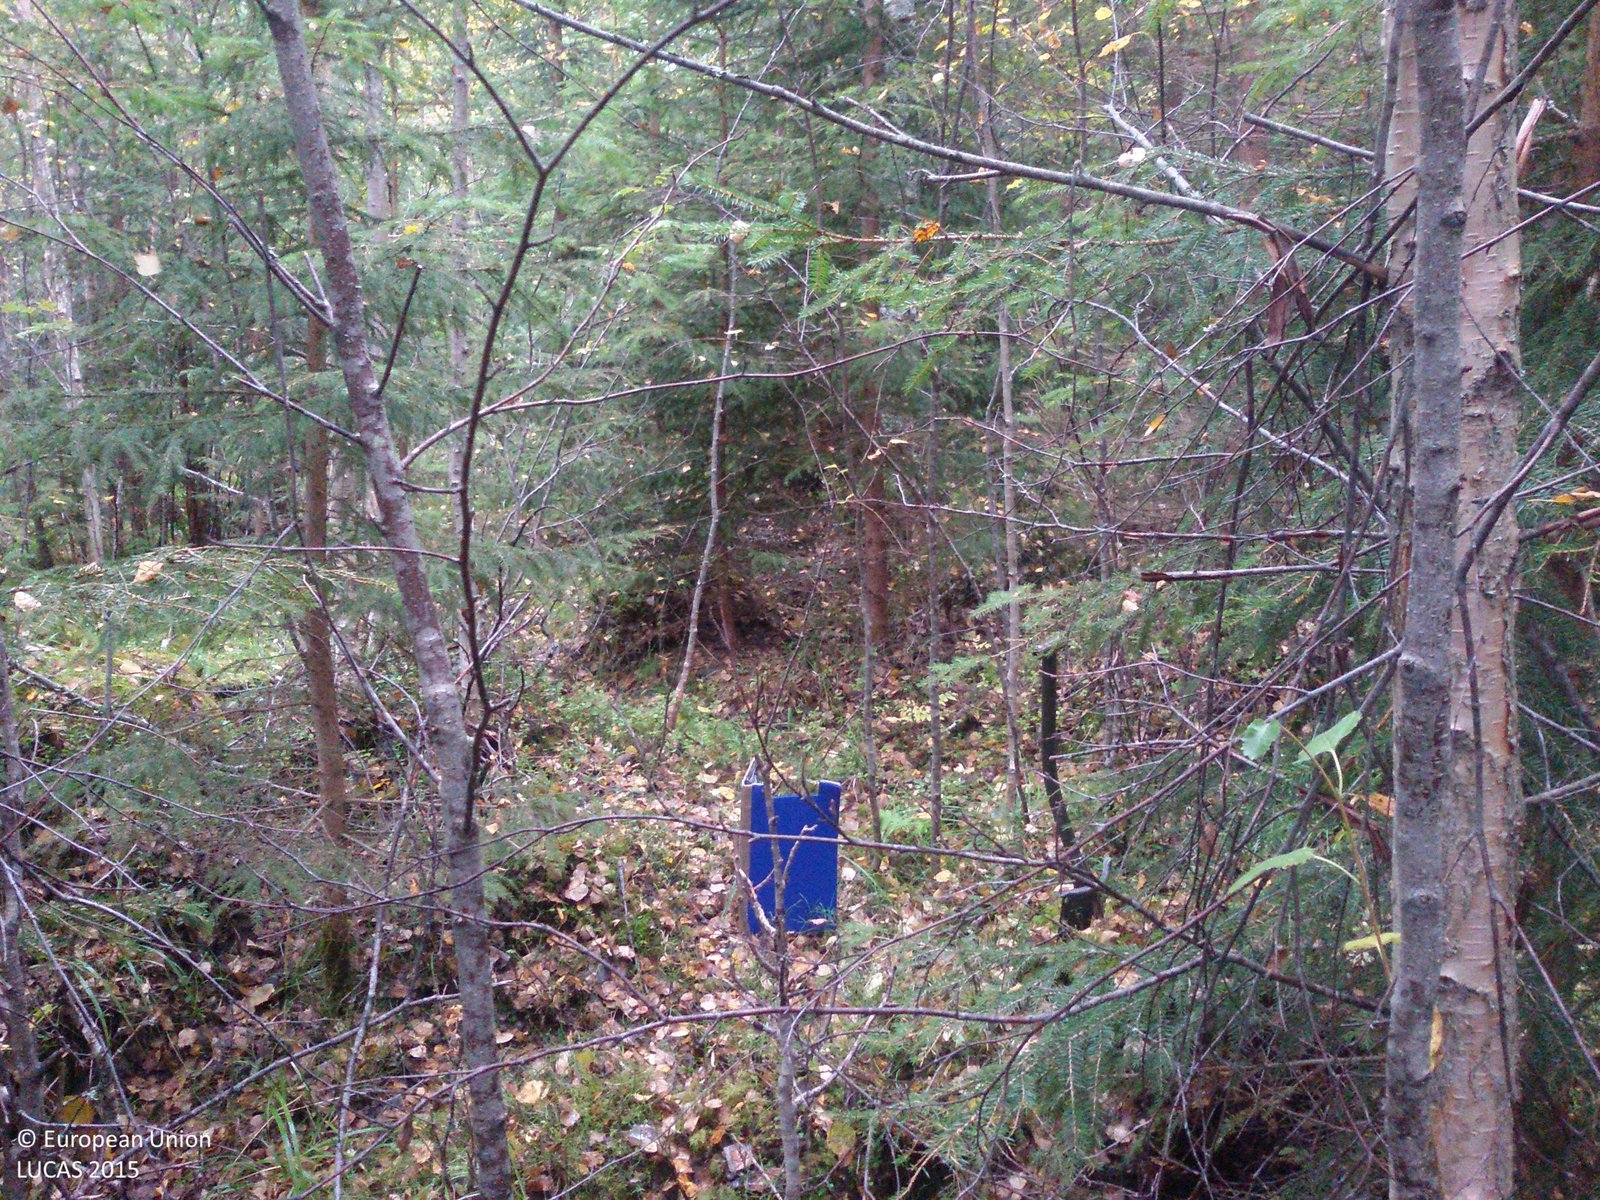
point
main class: Woodland
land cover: Spruce dominated mixed woodland
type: boreal forest
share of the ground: > 75 %
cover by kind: coniferous forest trees 50 %, broadleaved forest trees 40 %, herbaceous plants 10 %
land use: Forestry
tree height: > 5 m
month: September
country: SE
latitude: 60.6738
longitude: 14.8743
